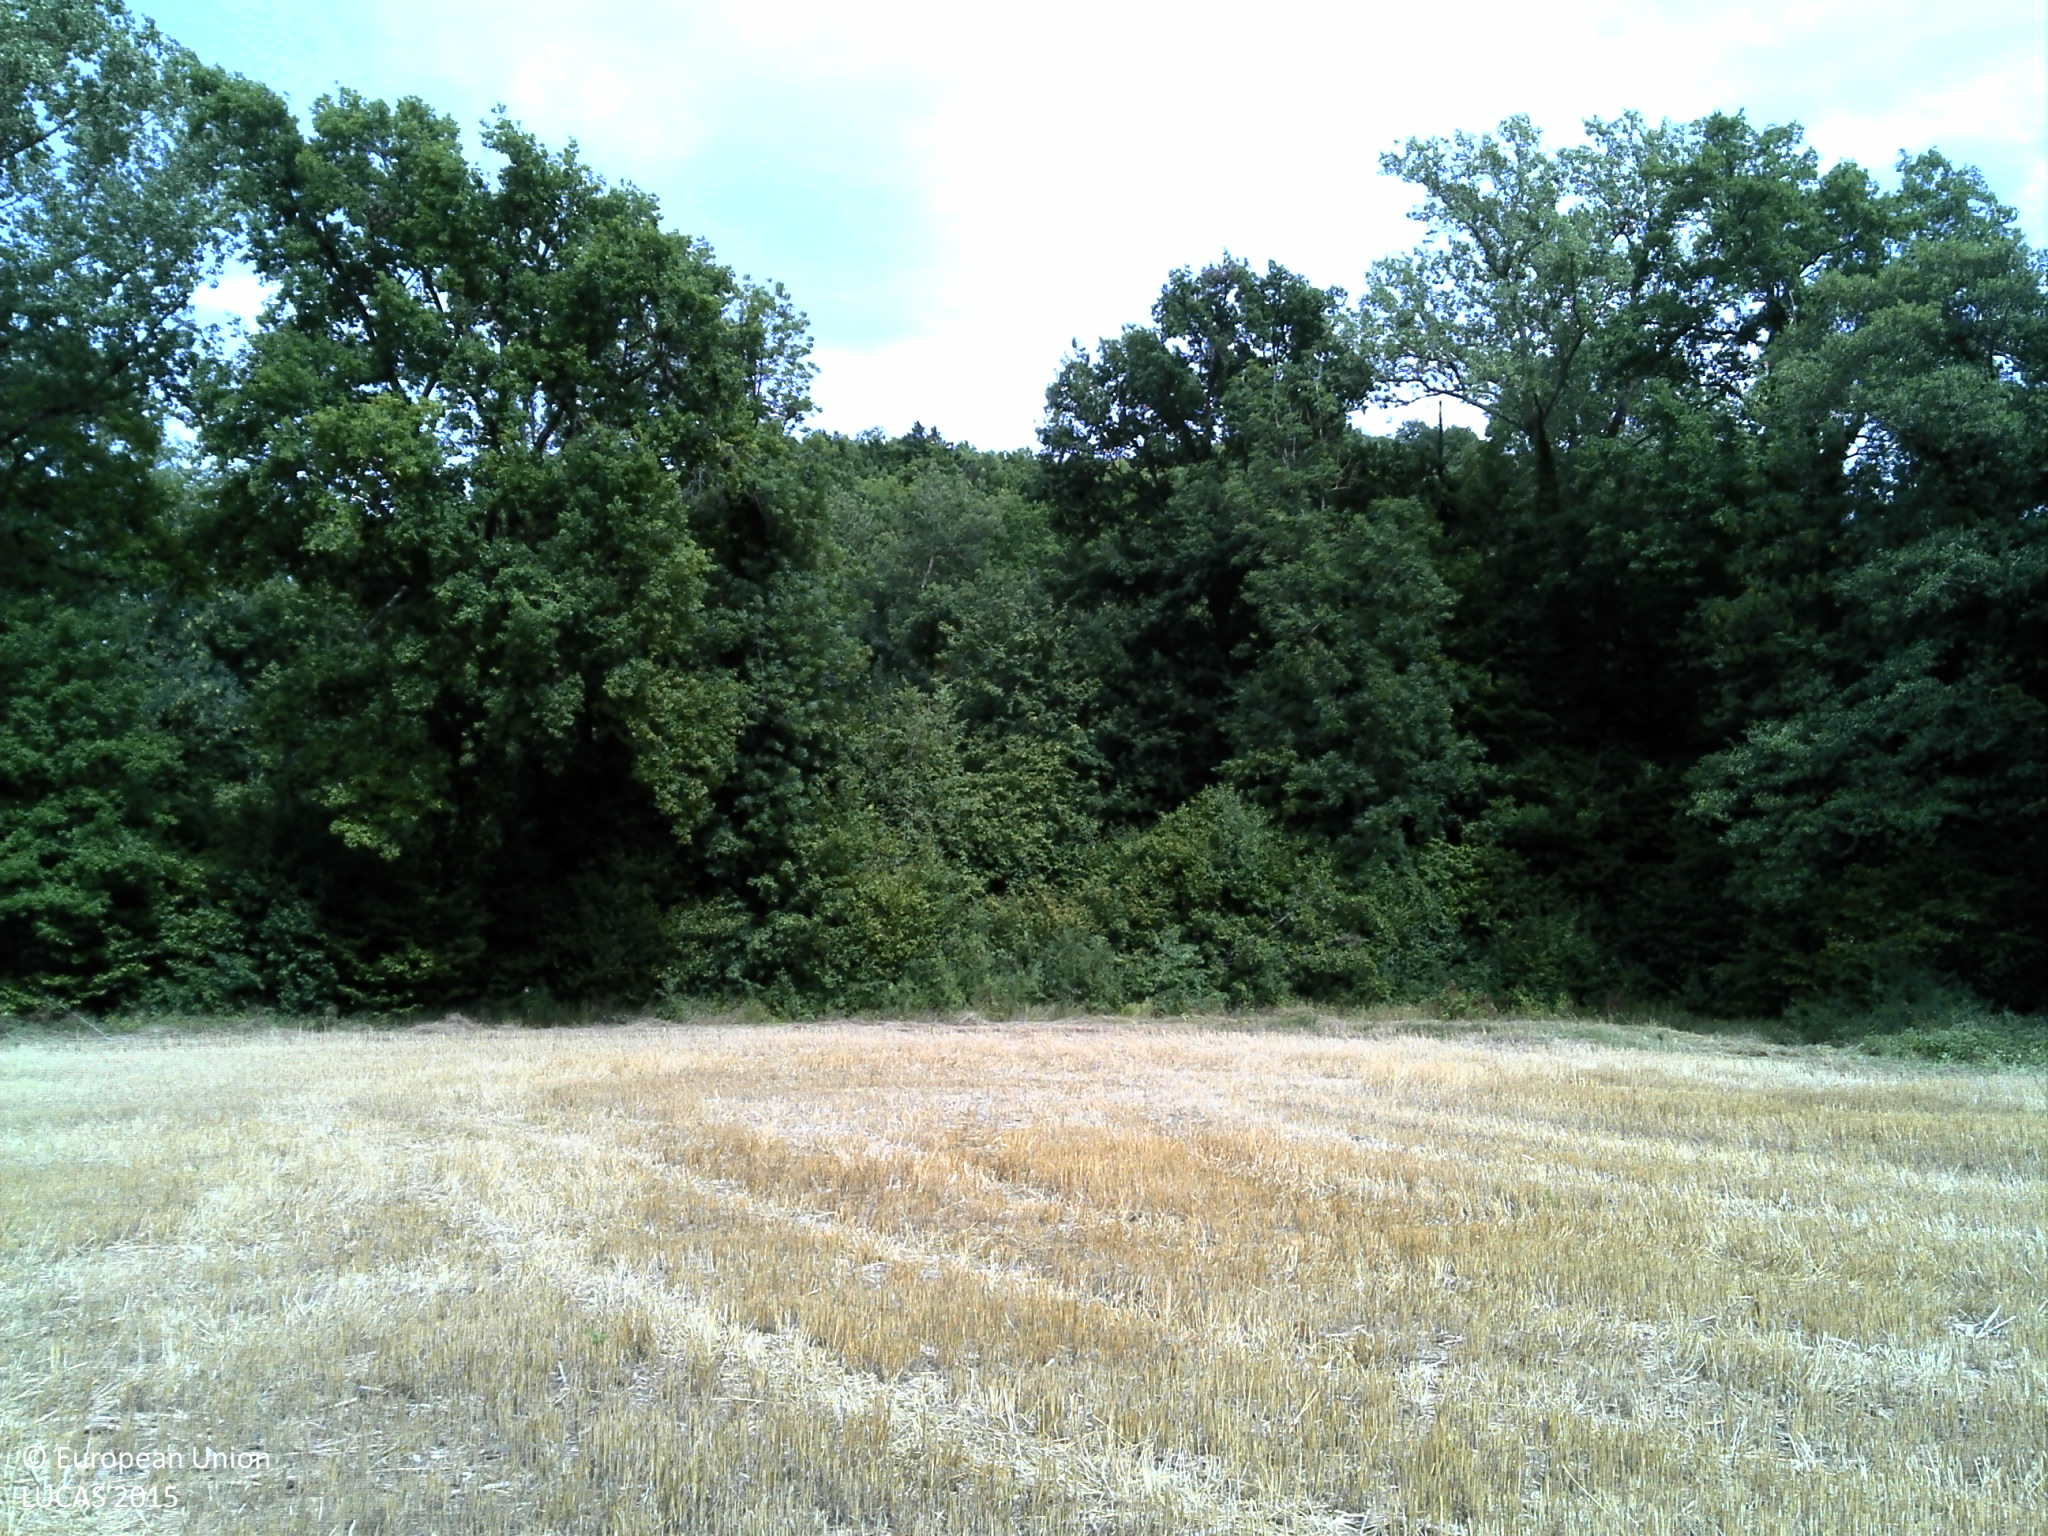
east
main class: Cropland
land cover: Common wheat
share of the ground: > 75 %
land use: Agriculture (excluding fallow land and kitchen gardens)
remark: Harvested field
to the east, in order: Common wheat; Broadleaved woodland; Rivers and streams; Broadleaved woodland; Grassland with sparse tree/shrub cover; Grassland without tree/shrub cover; Broadleaved woodland; Other bare soil; Broadleaved woodland
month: July
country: FR
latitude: 45.7094
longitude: 3.3339
